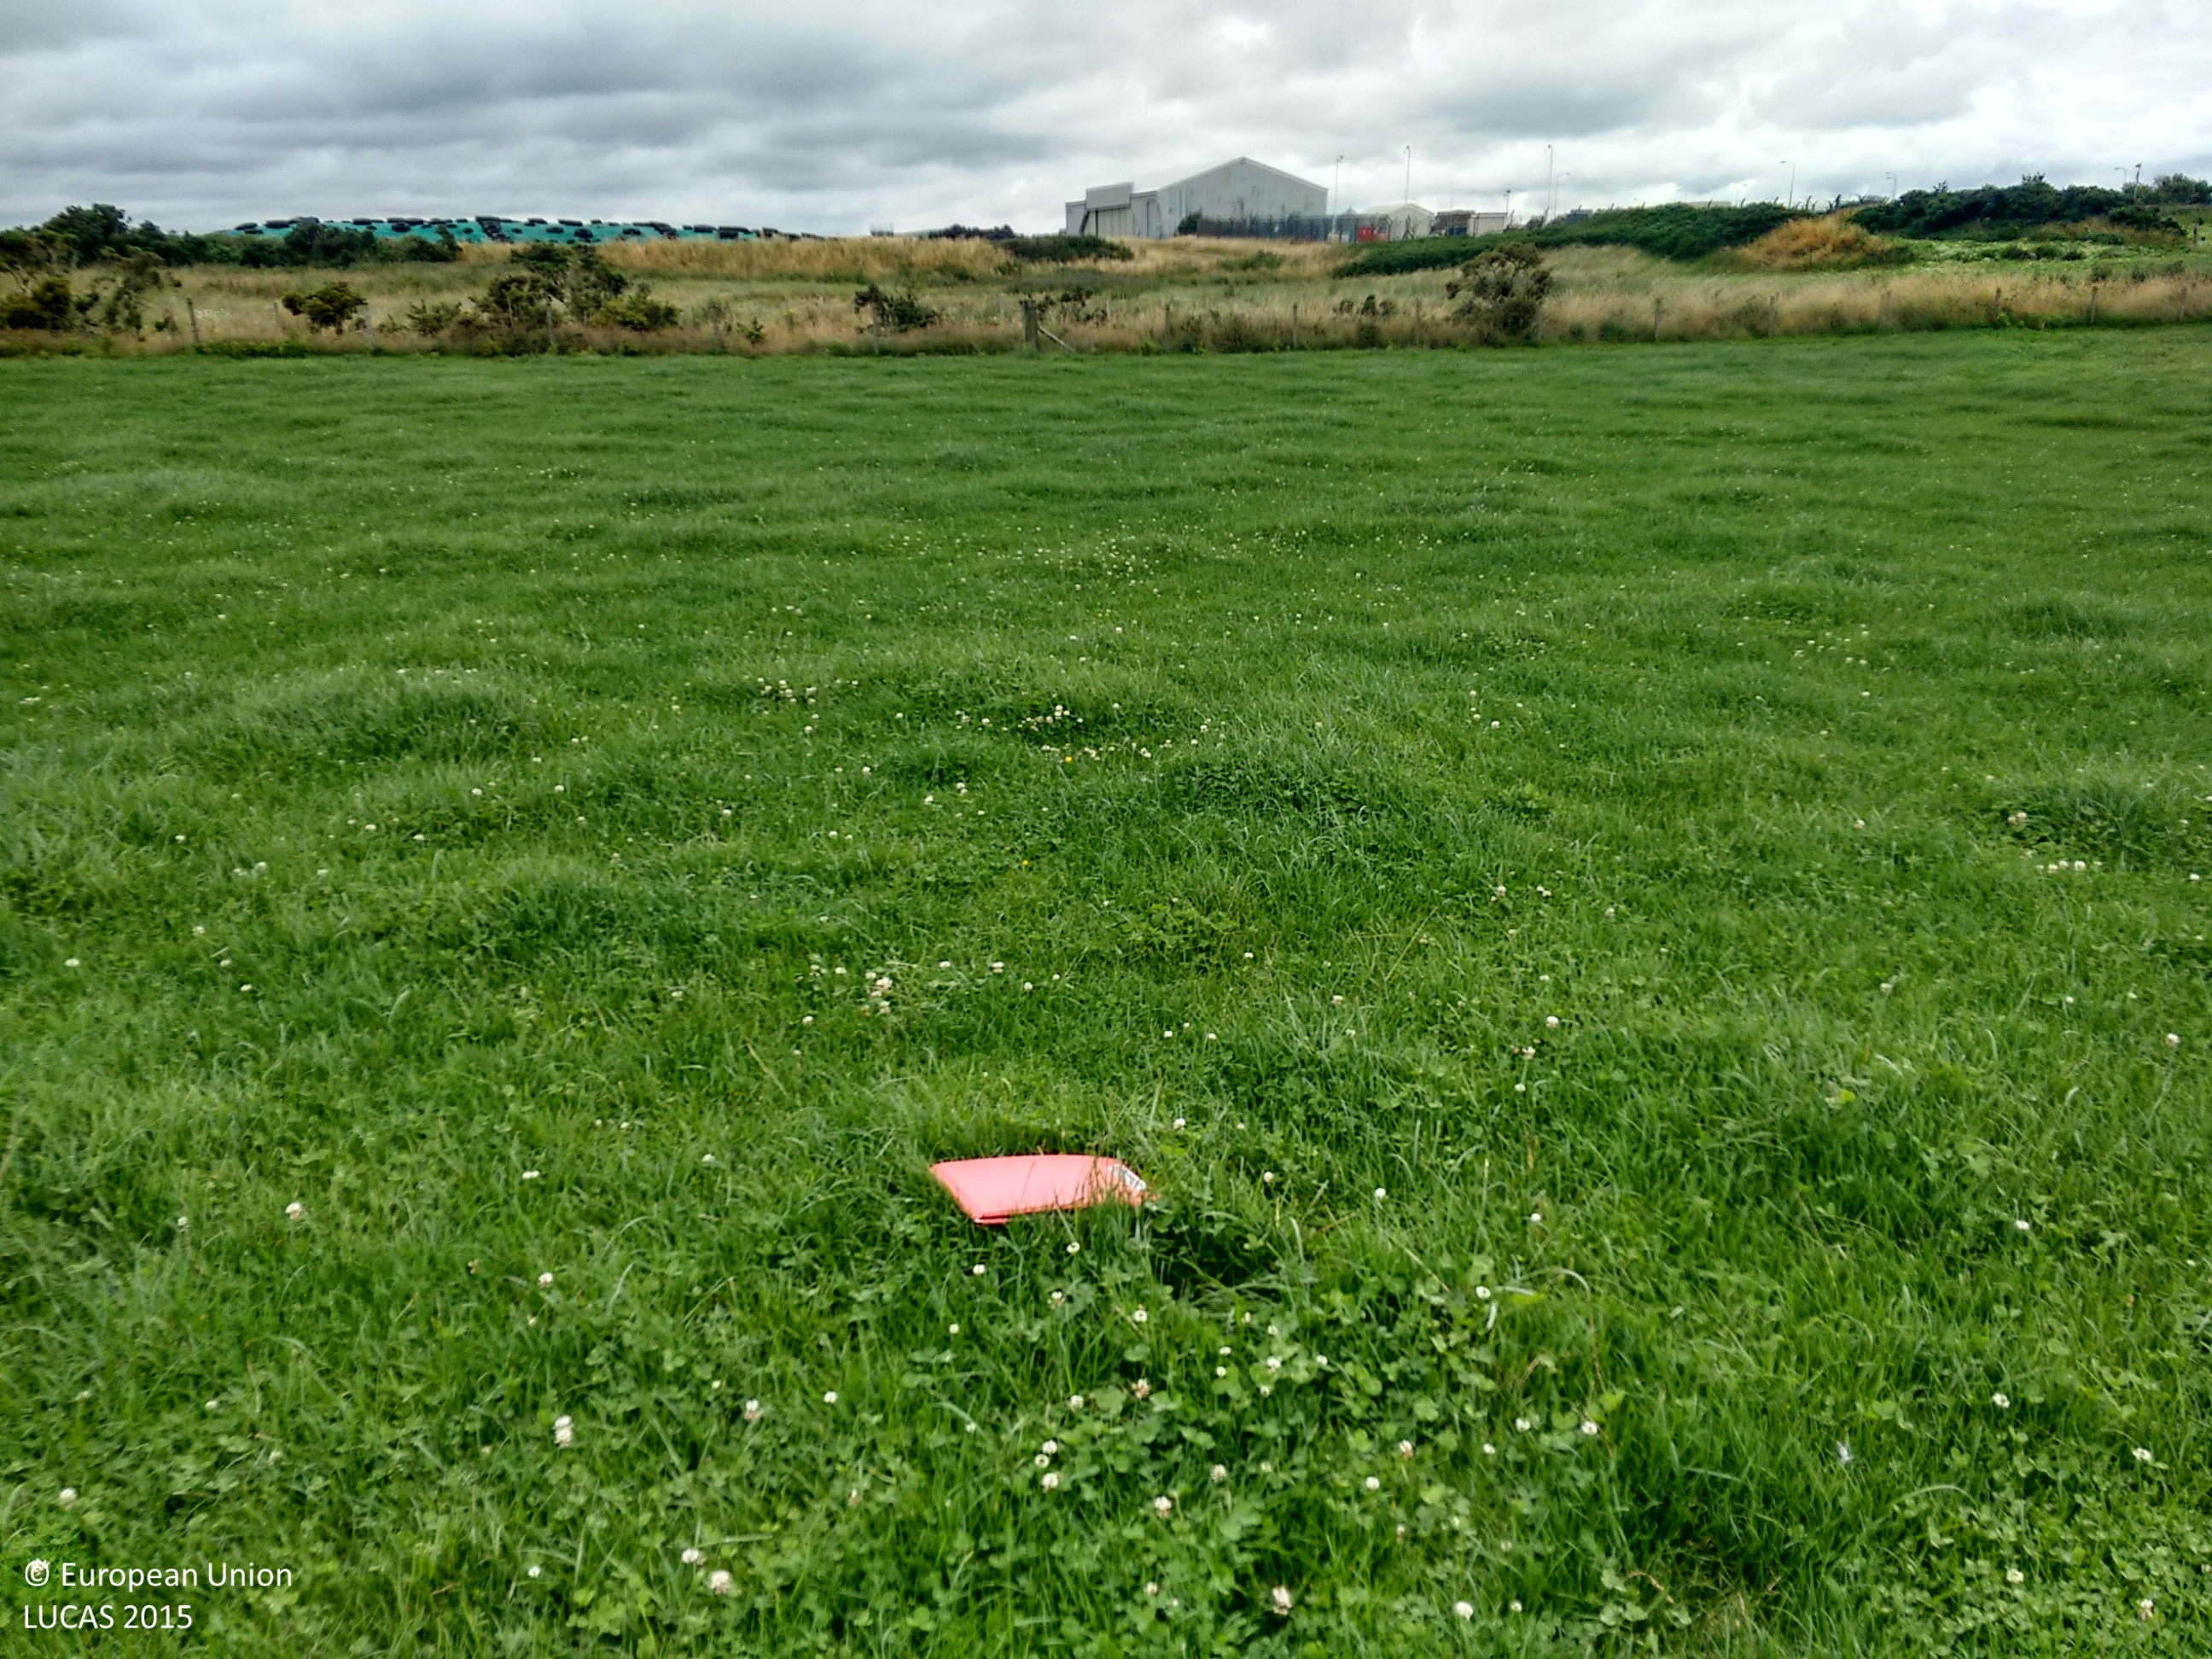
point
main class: Grassland
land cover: Grassland without tree/shrub cover
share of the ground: > 75 %
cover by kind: herbaceous plants 100 %
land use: Agriculture (excluding fallow land and kitchen gardens)
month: August
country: GB
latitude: 54.8462
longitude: -4.9543
